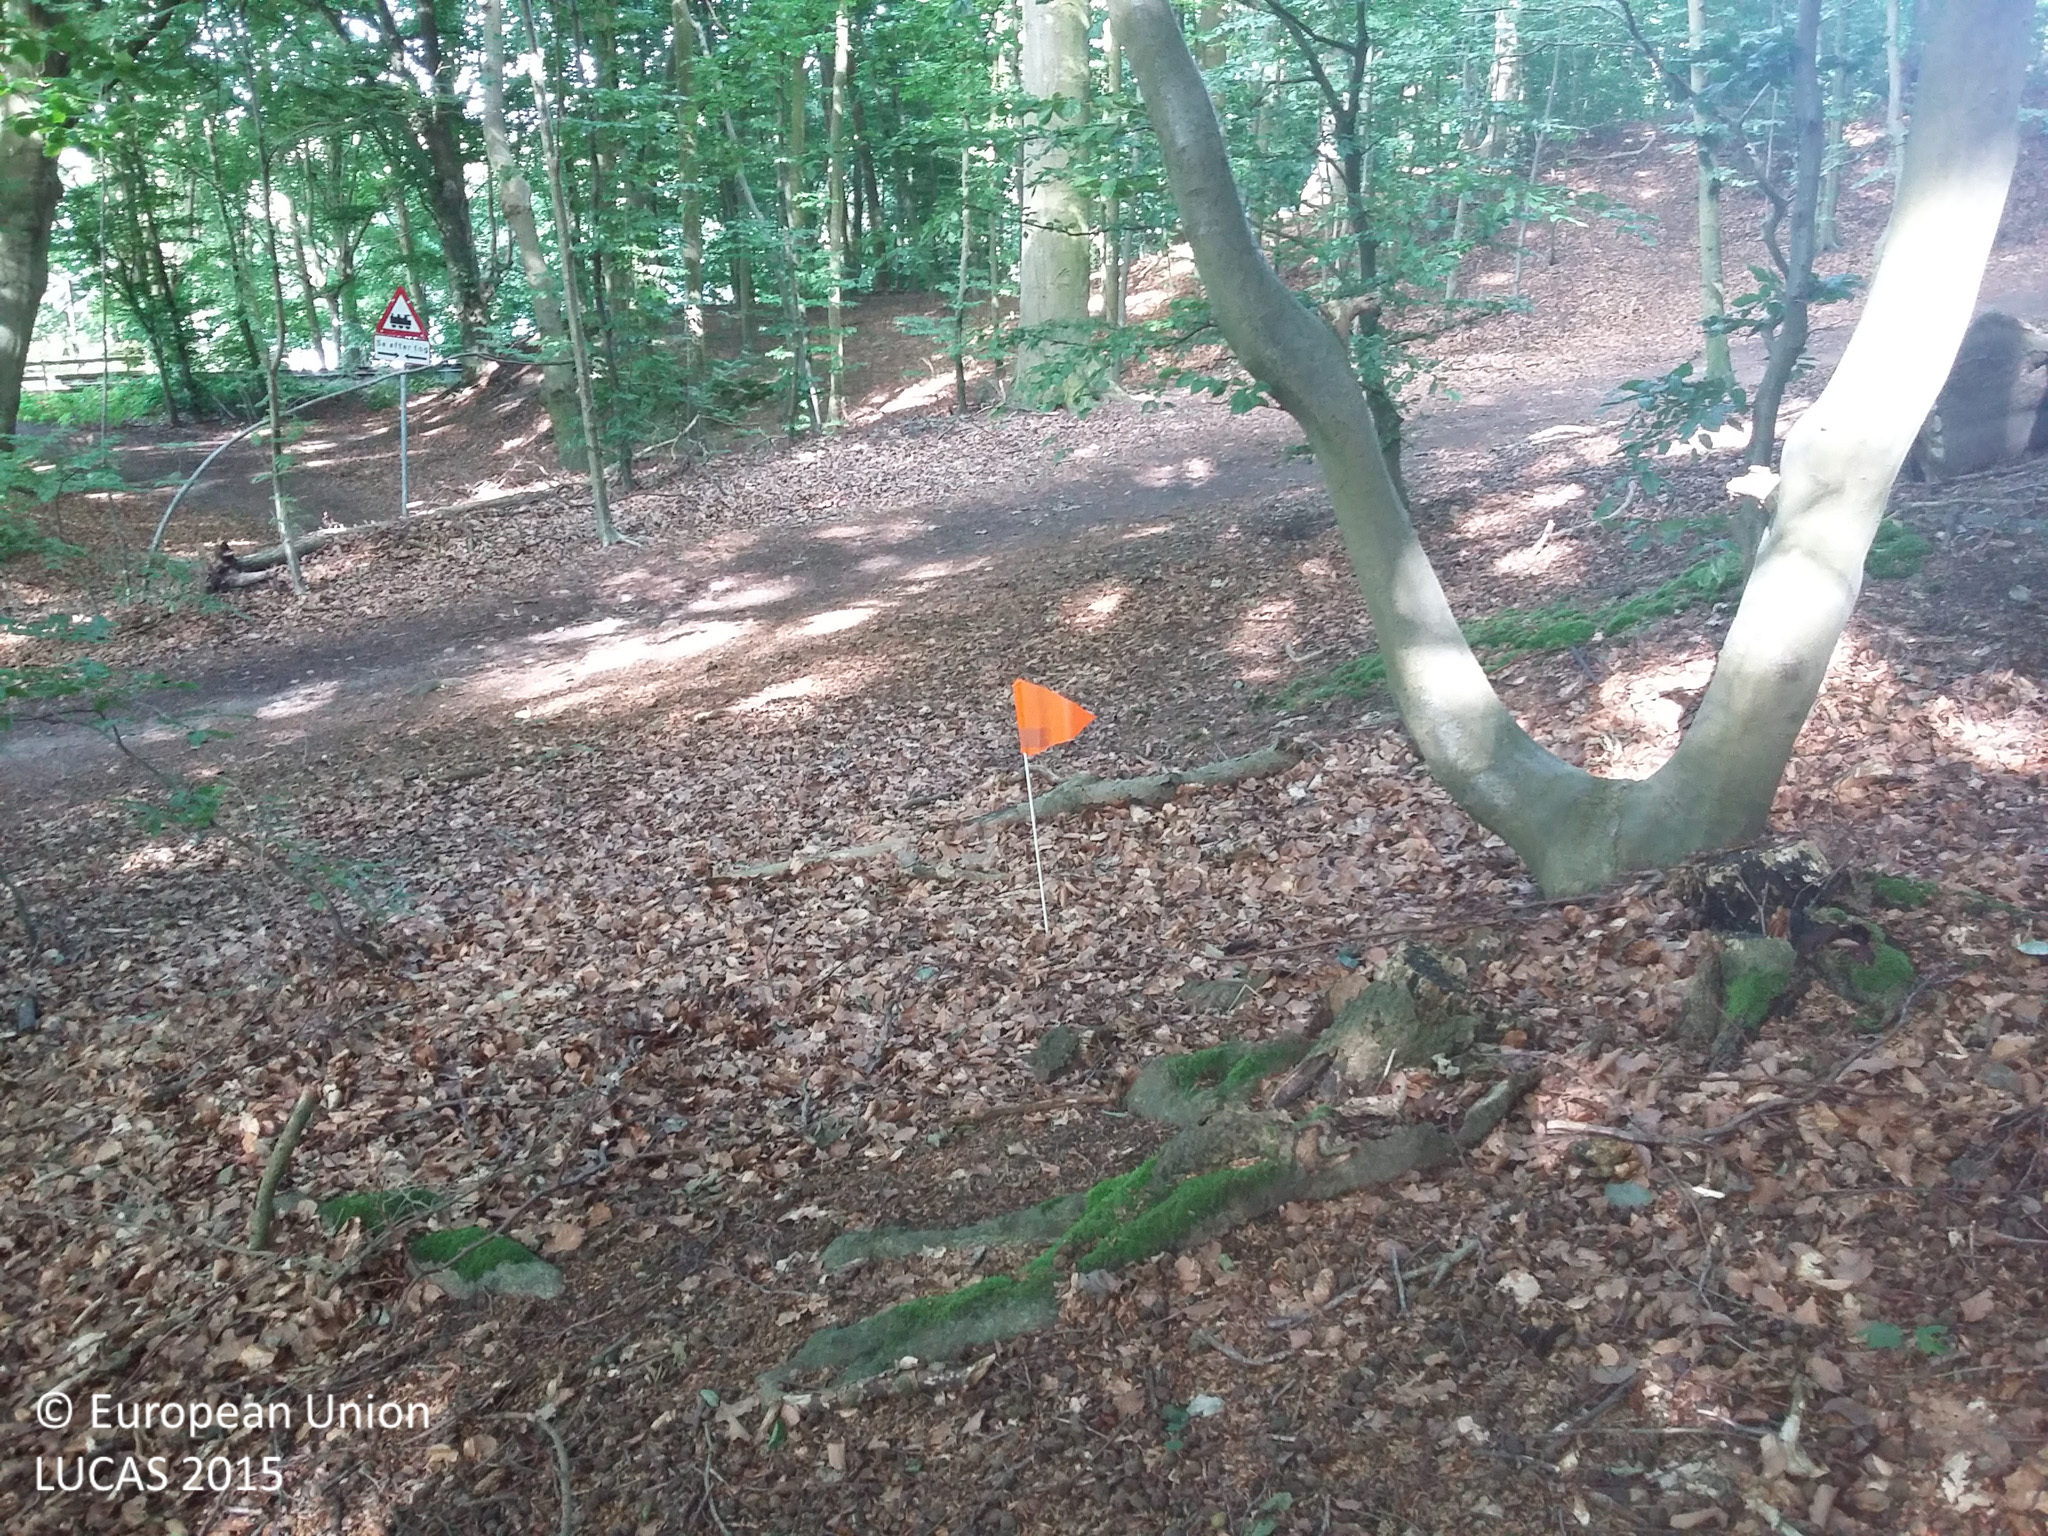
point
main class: Woodland
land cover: Broadleaved woodland
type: beech forest
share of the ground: > 75 %
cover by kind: broadleaved forest trees 95 %, herbaceous plants 5 %
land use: Amenities, museums, leisure
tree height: > 5 m
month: July
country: DK
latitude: 56.0539
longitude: 12.5829
